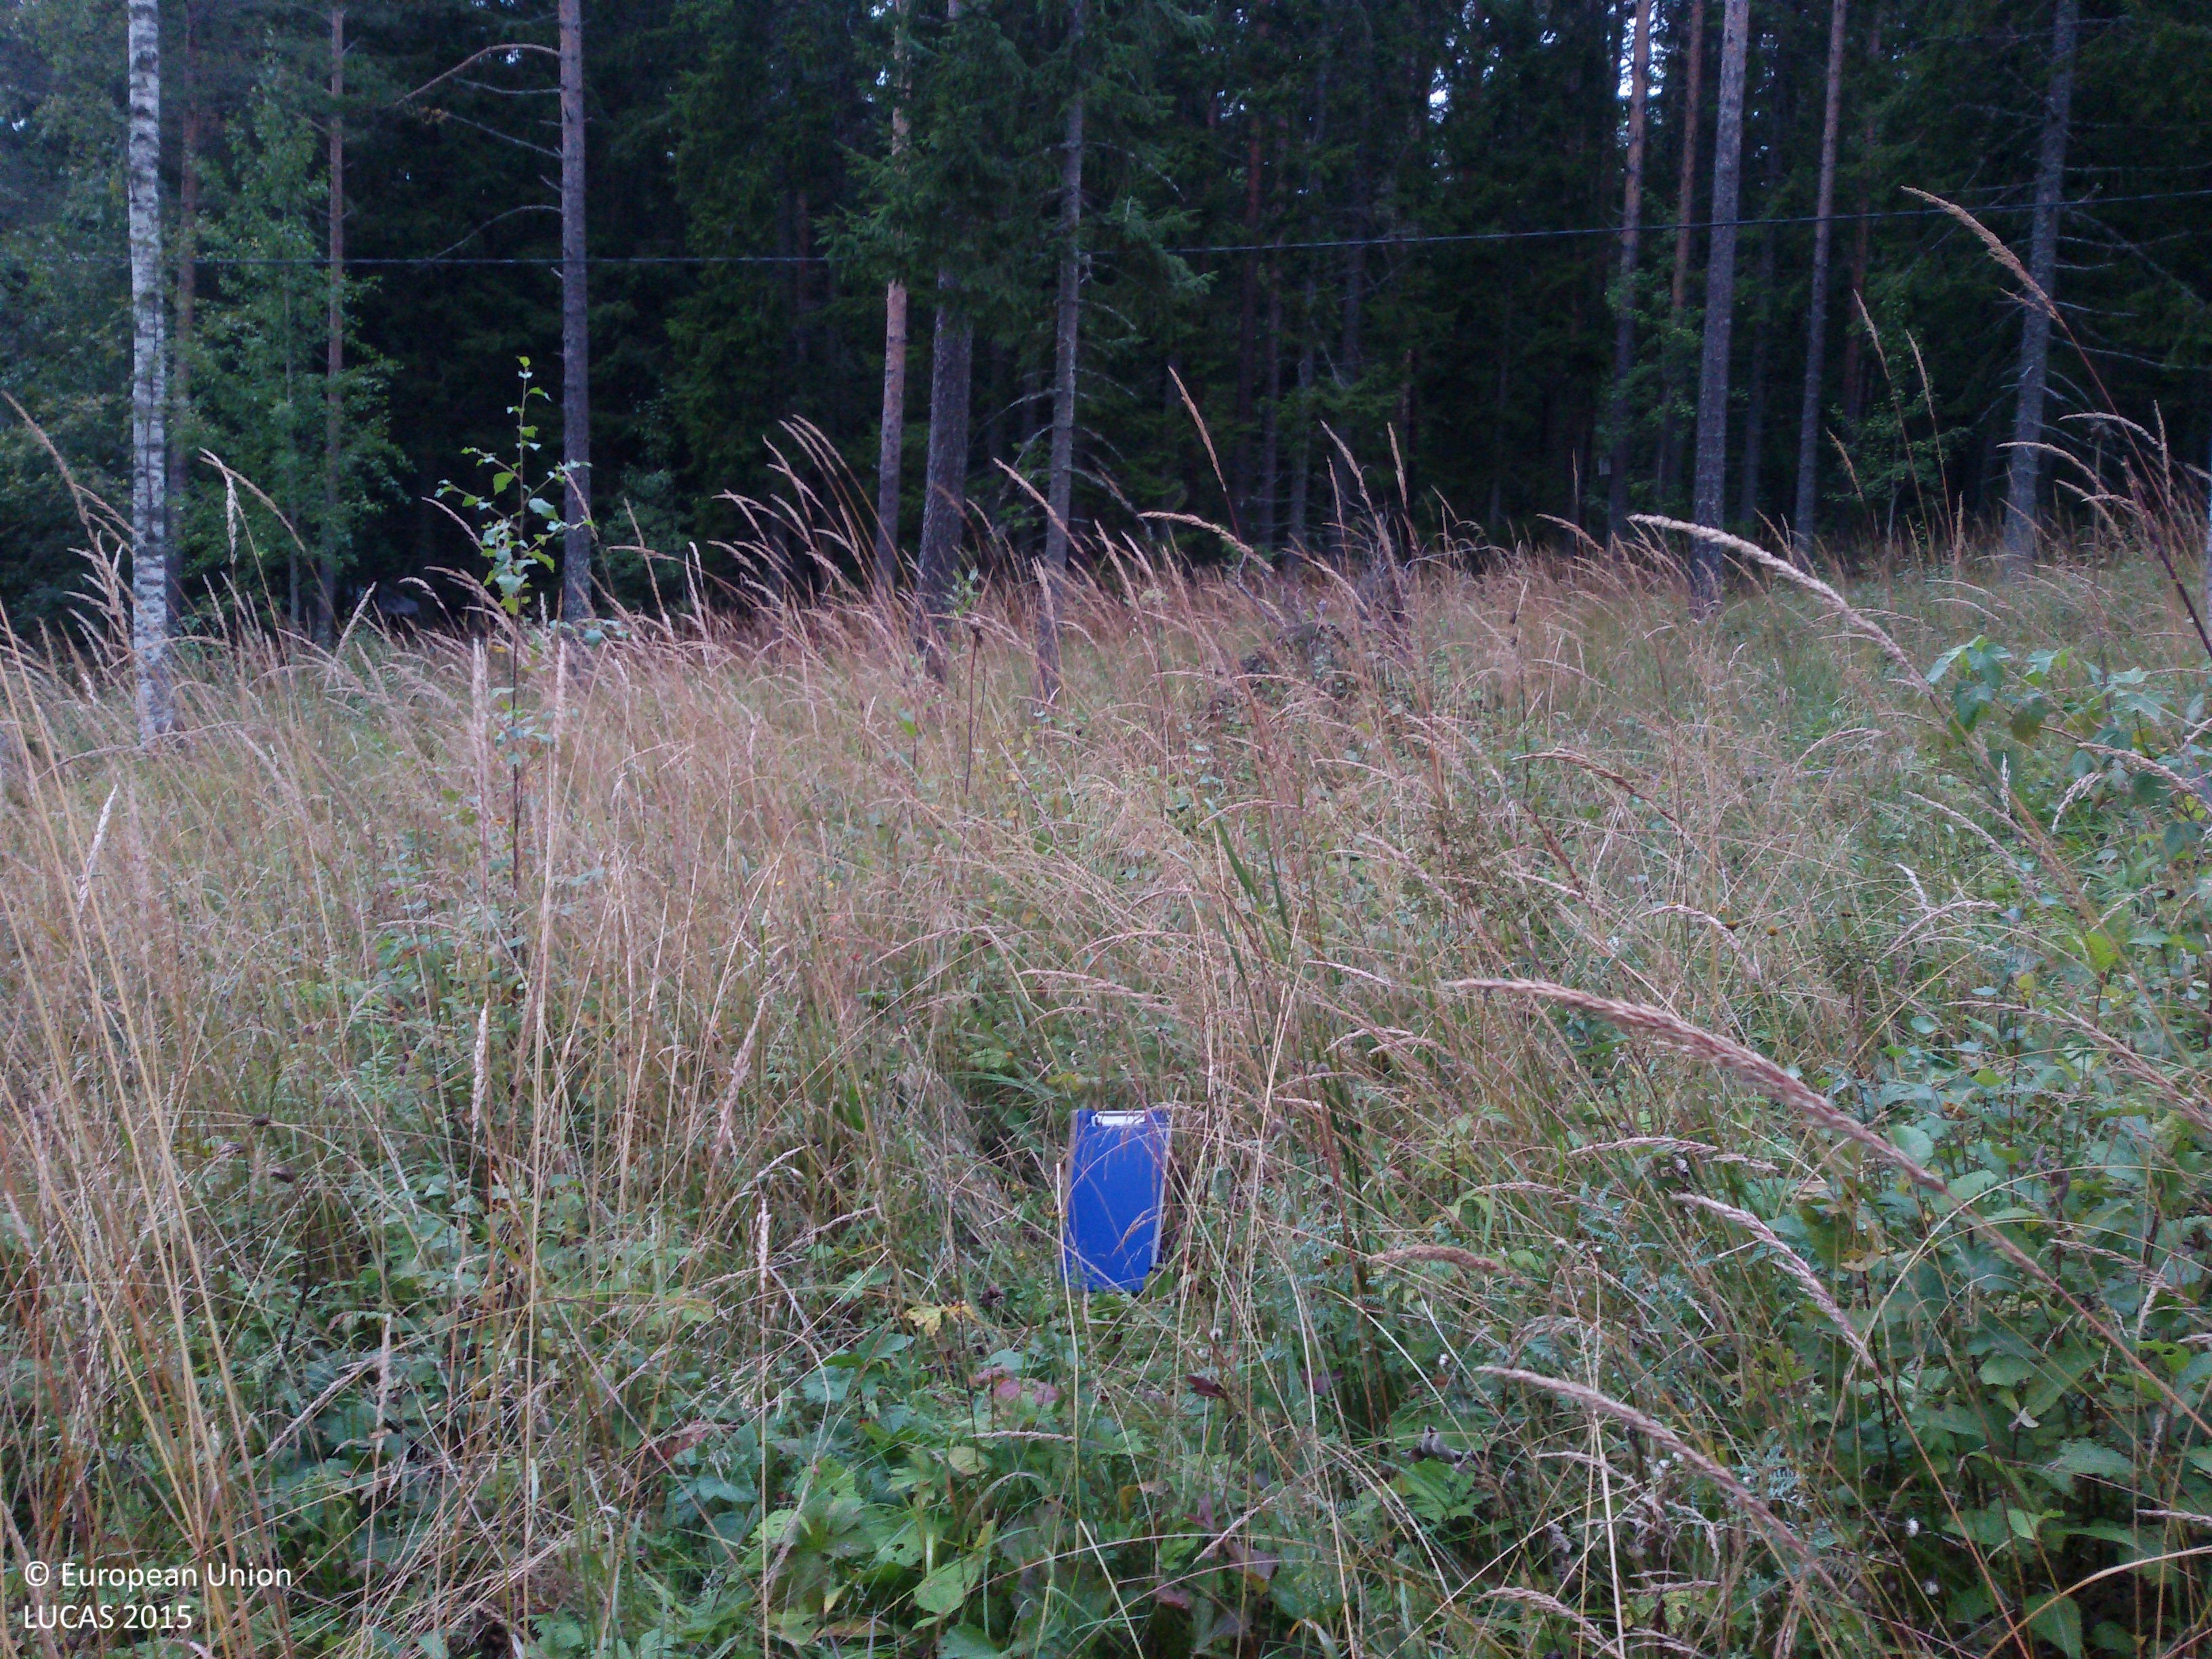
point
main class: Woodland
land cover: Pine dominated mixed woodland
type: boreal forest
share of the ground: 25 - 50 %
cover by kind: herbaceous plants 70 %, coniferous forest trees 15 %, broadleaved forest trees 15 %
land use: Forestry
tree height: > 5 m
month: September
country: SE
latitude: 60.8184
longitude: 15.3737
